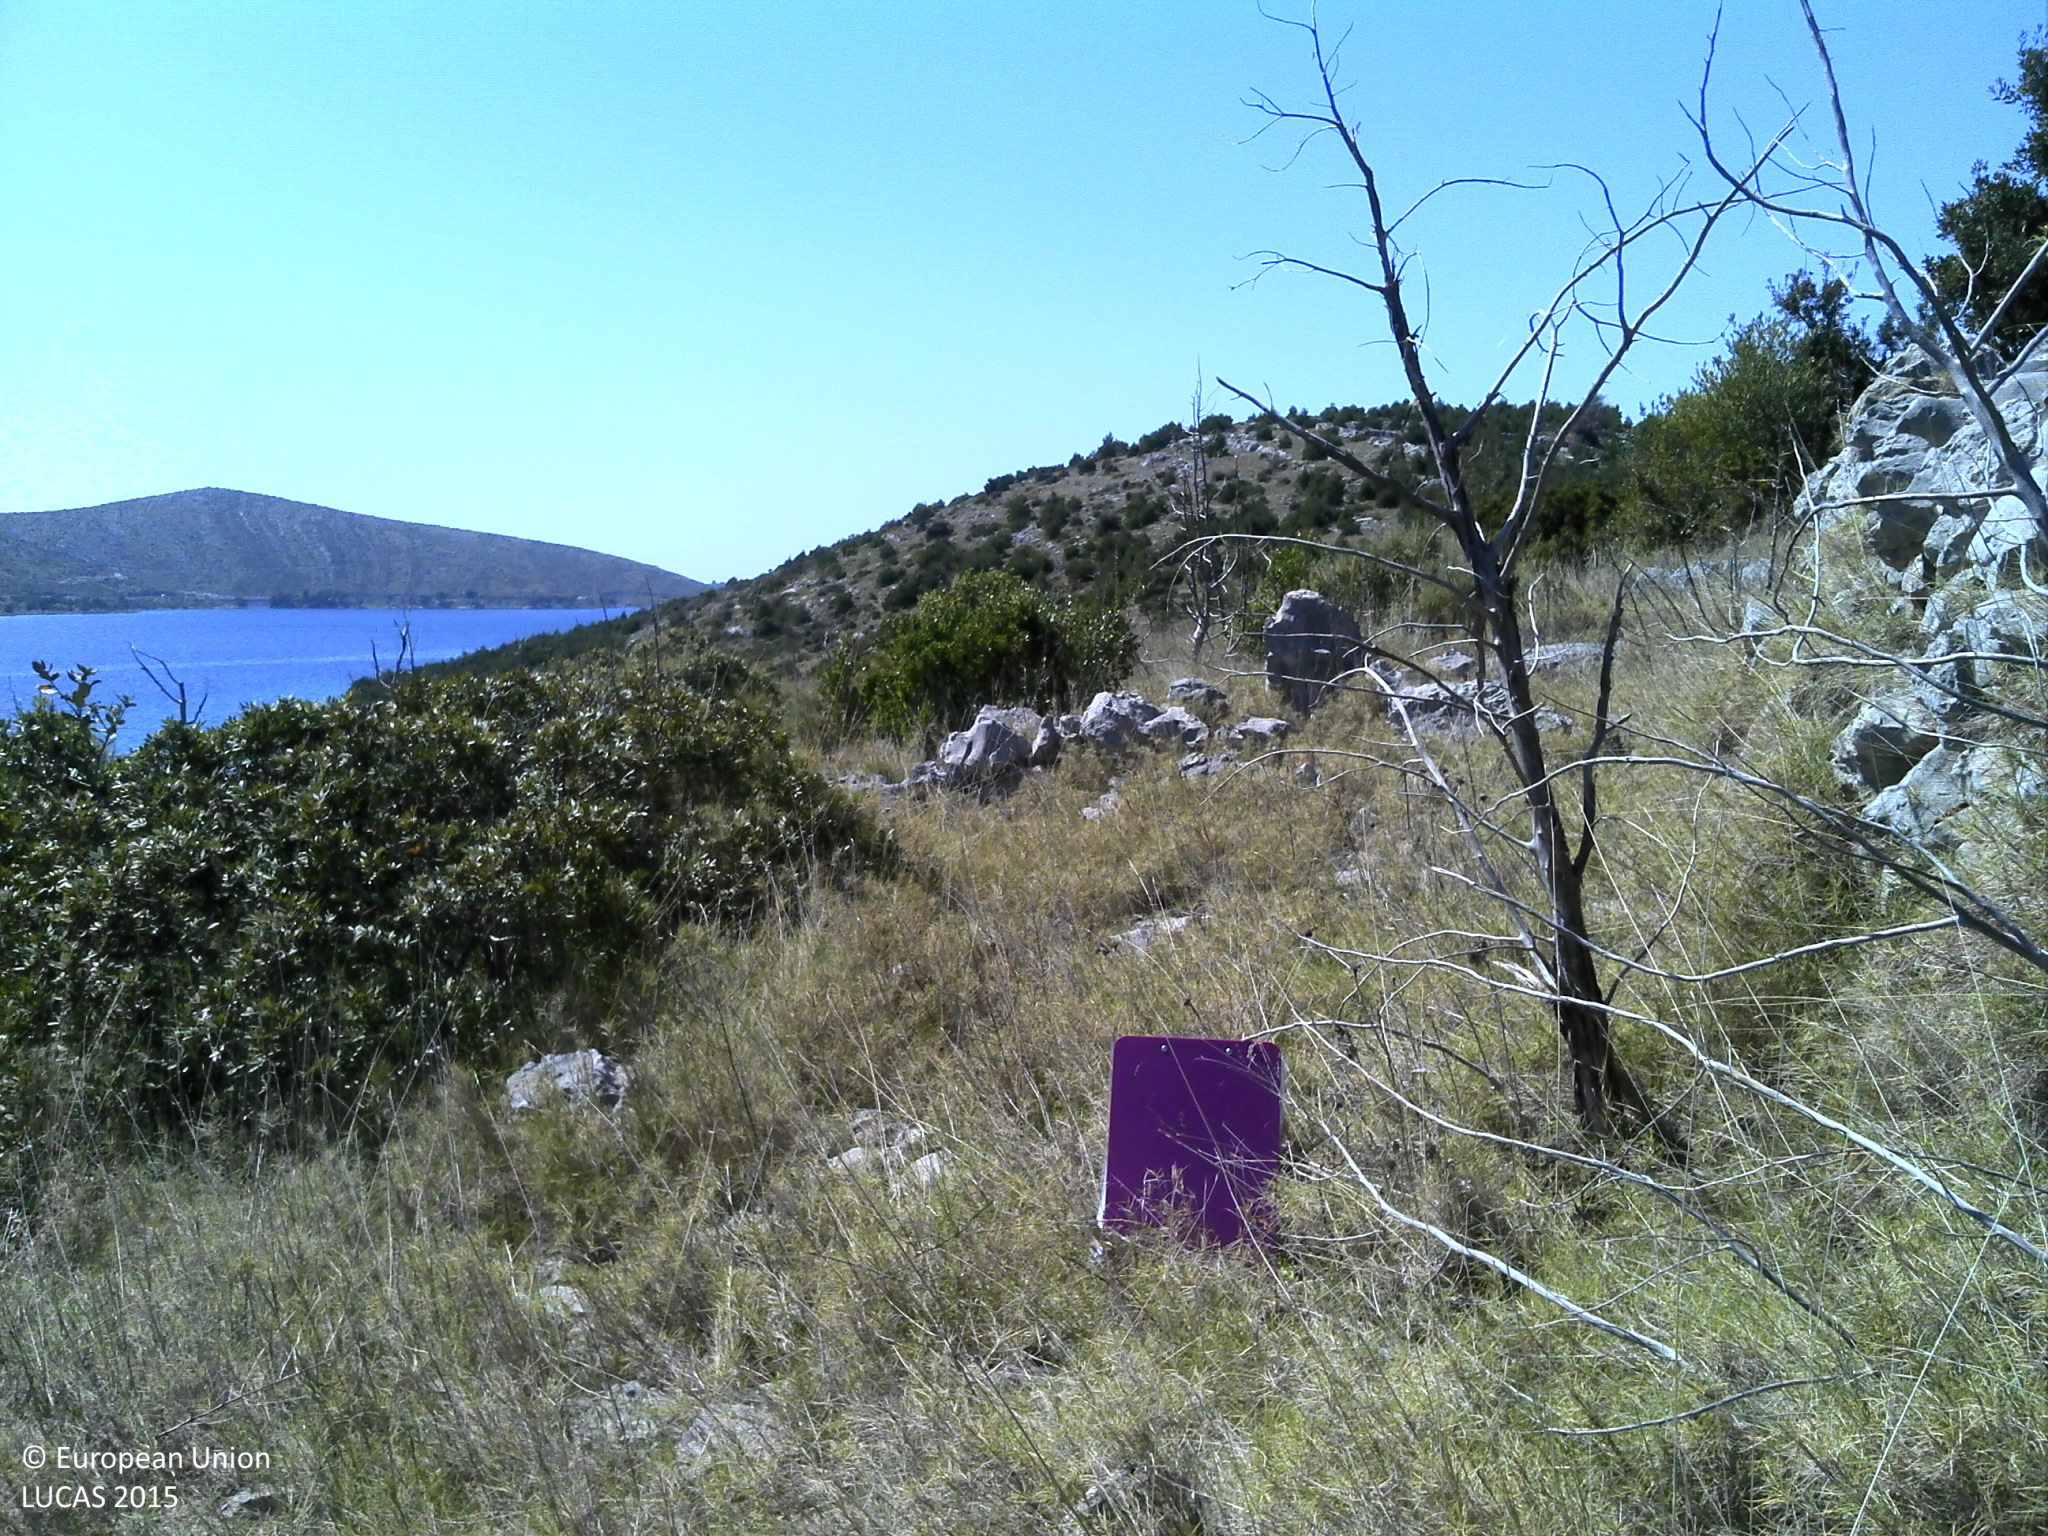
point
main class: Shrubland
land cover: Shrubland with sparse tree cover
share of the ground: 10 - 25 %
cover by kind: herbaceous plants 30 %, shrubs 25 %, consolidated bare surface 20 %, unconsolidated bare surface 20 %, coniferous forest trees 5 %
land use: Abandoned areas
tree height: < 5 m
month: April
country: HR
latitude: 43.6371
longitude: 15.9530
